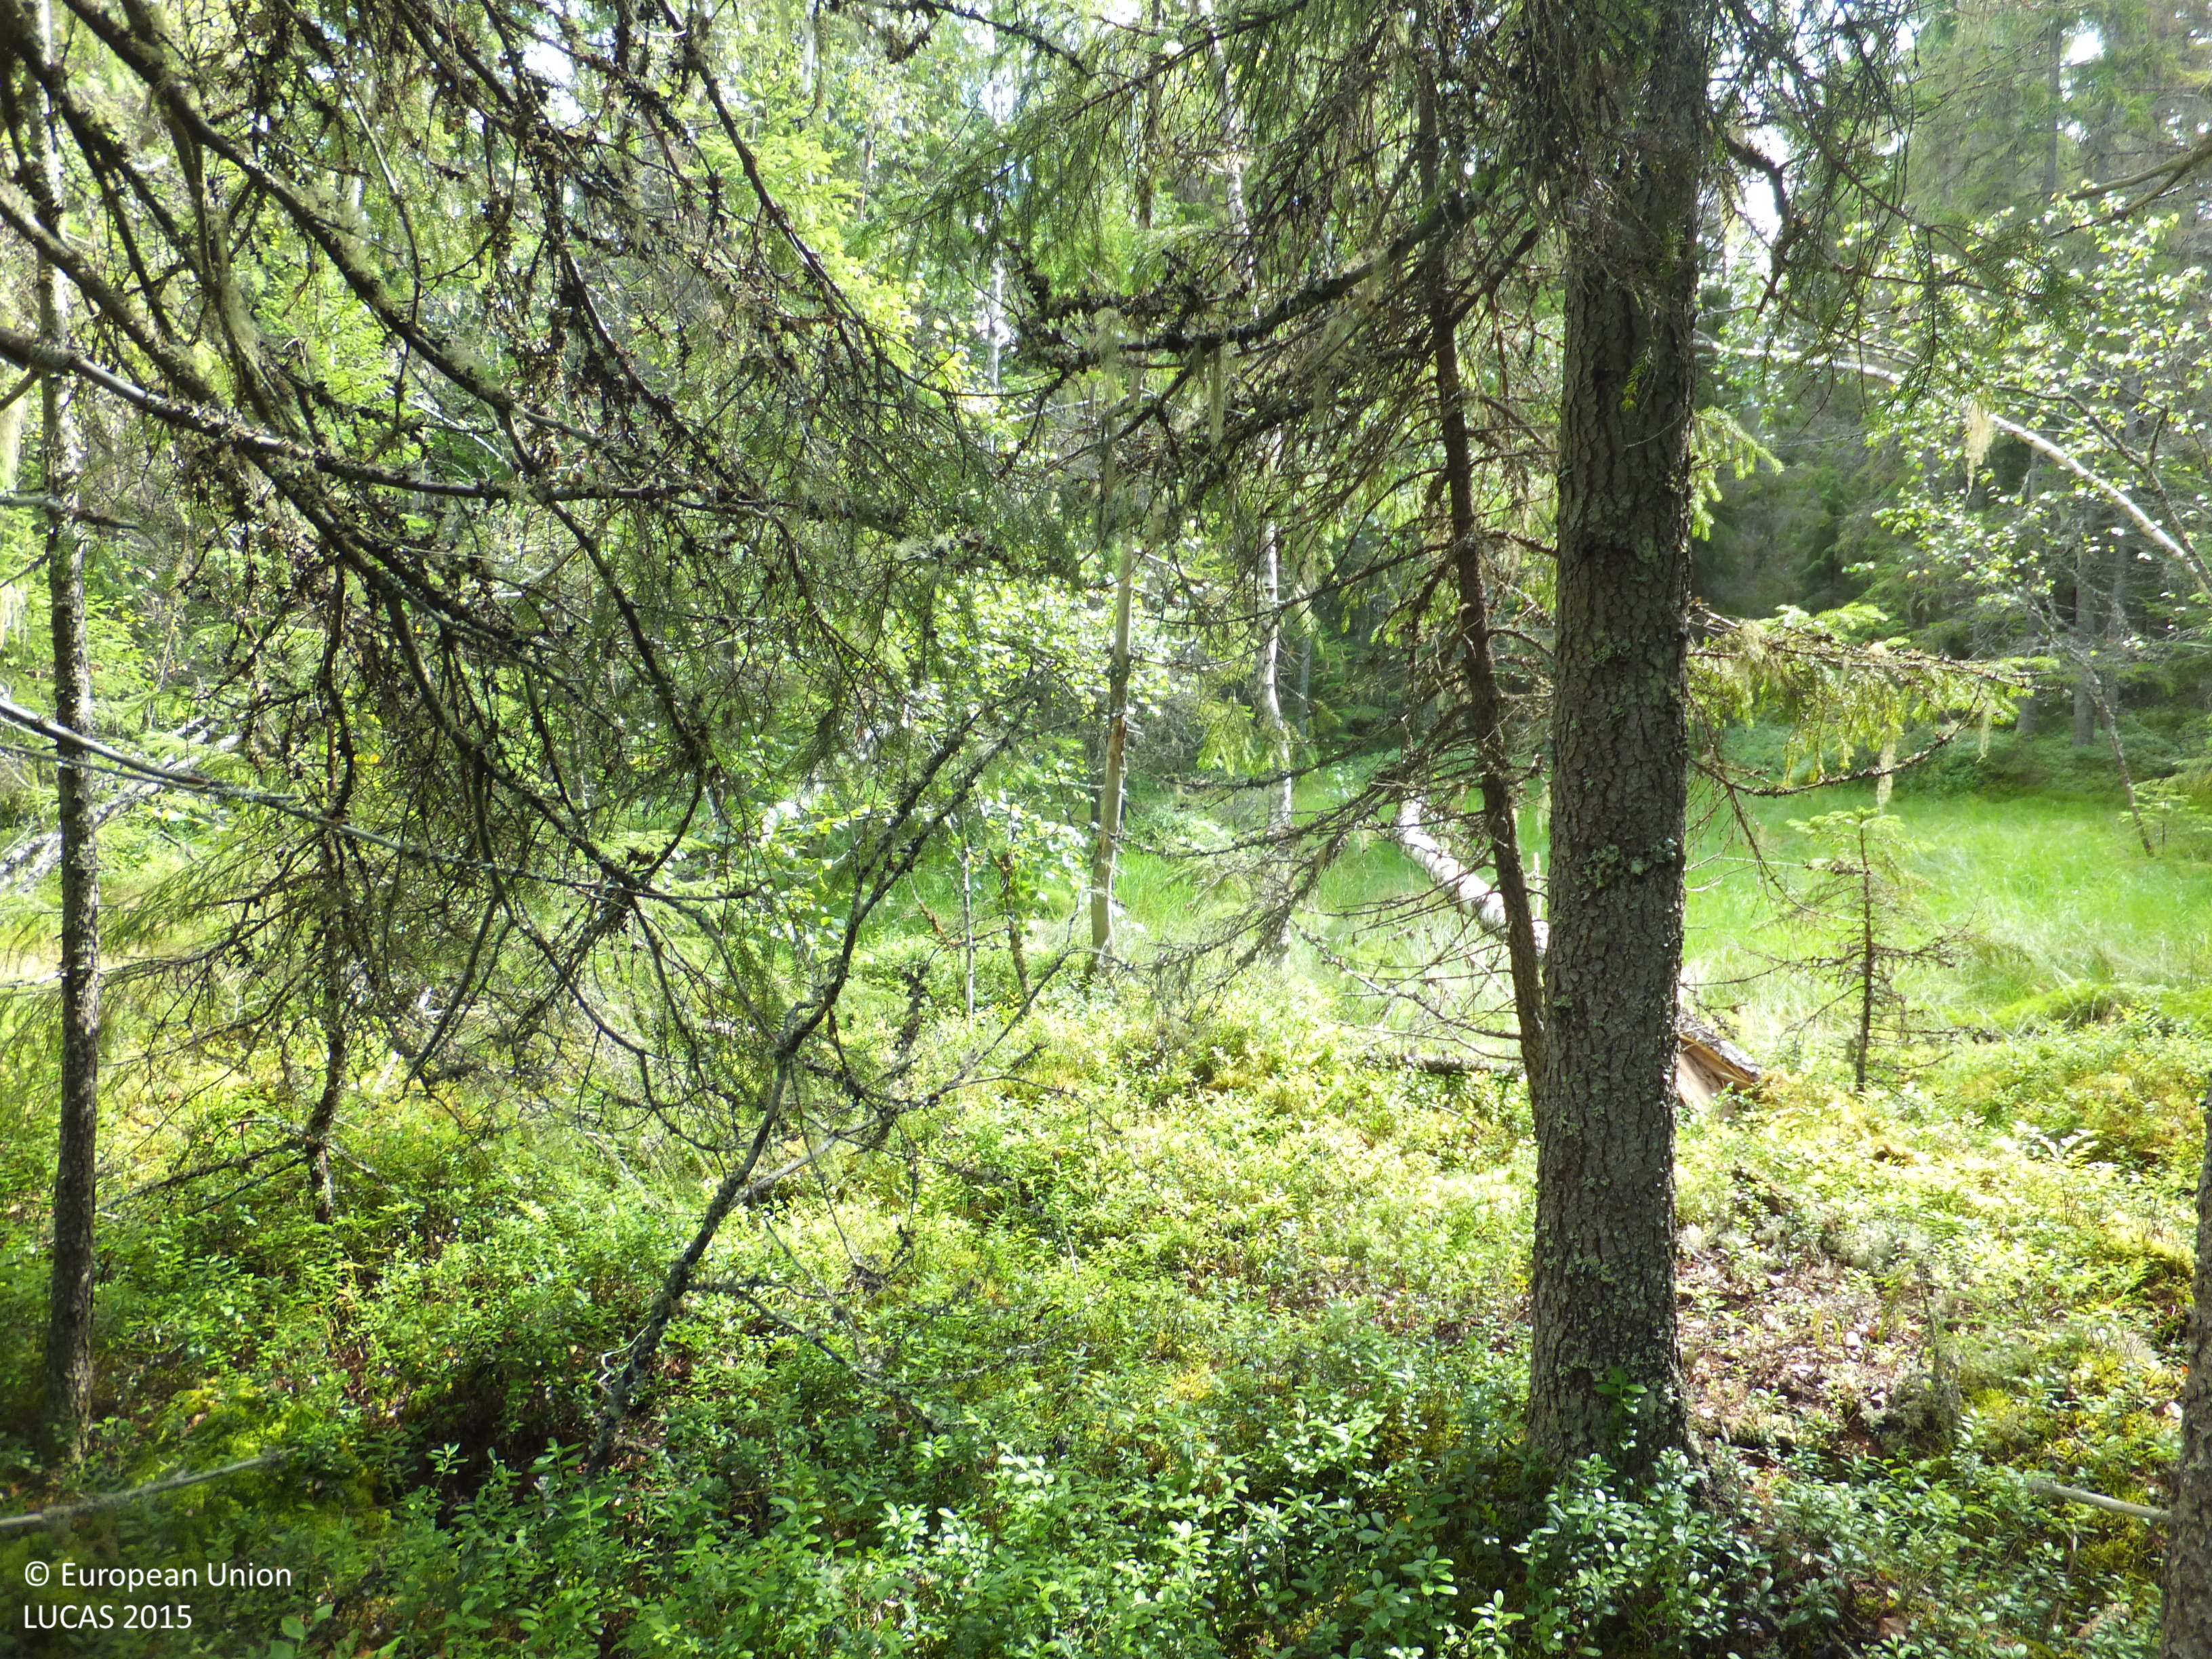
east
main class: Woodland
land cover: Spruce dominated coniferous woodland
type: boreal forest
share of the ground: 50 - 75 %
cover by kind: coniferous forest trees 65 %, shrubs 15 %, lichens and mosses 10 %, broadleaved forest trees 5 %, herbaceous plants 5 %
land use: Forestry
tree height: > 5 m
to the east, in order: Spruce dominated coniferous woodland; Spruce dominated mixed woodland; Spruce dominated coniferous woodland; Spruce dominated mixed woodland; Grass margins; Barley
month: July
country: FI
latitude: 63.2743
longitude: 22.1023
